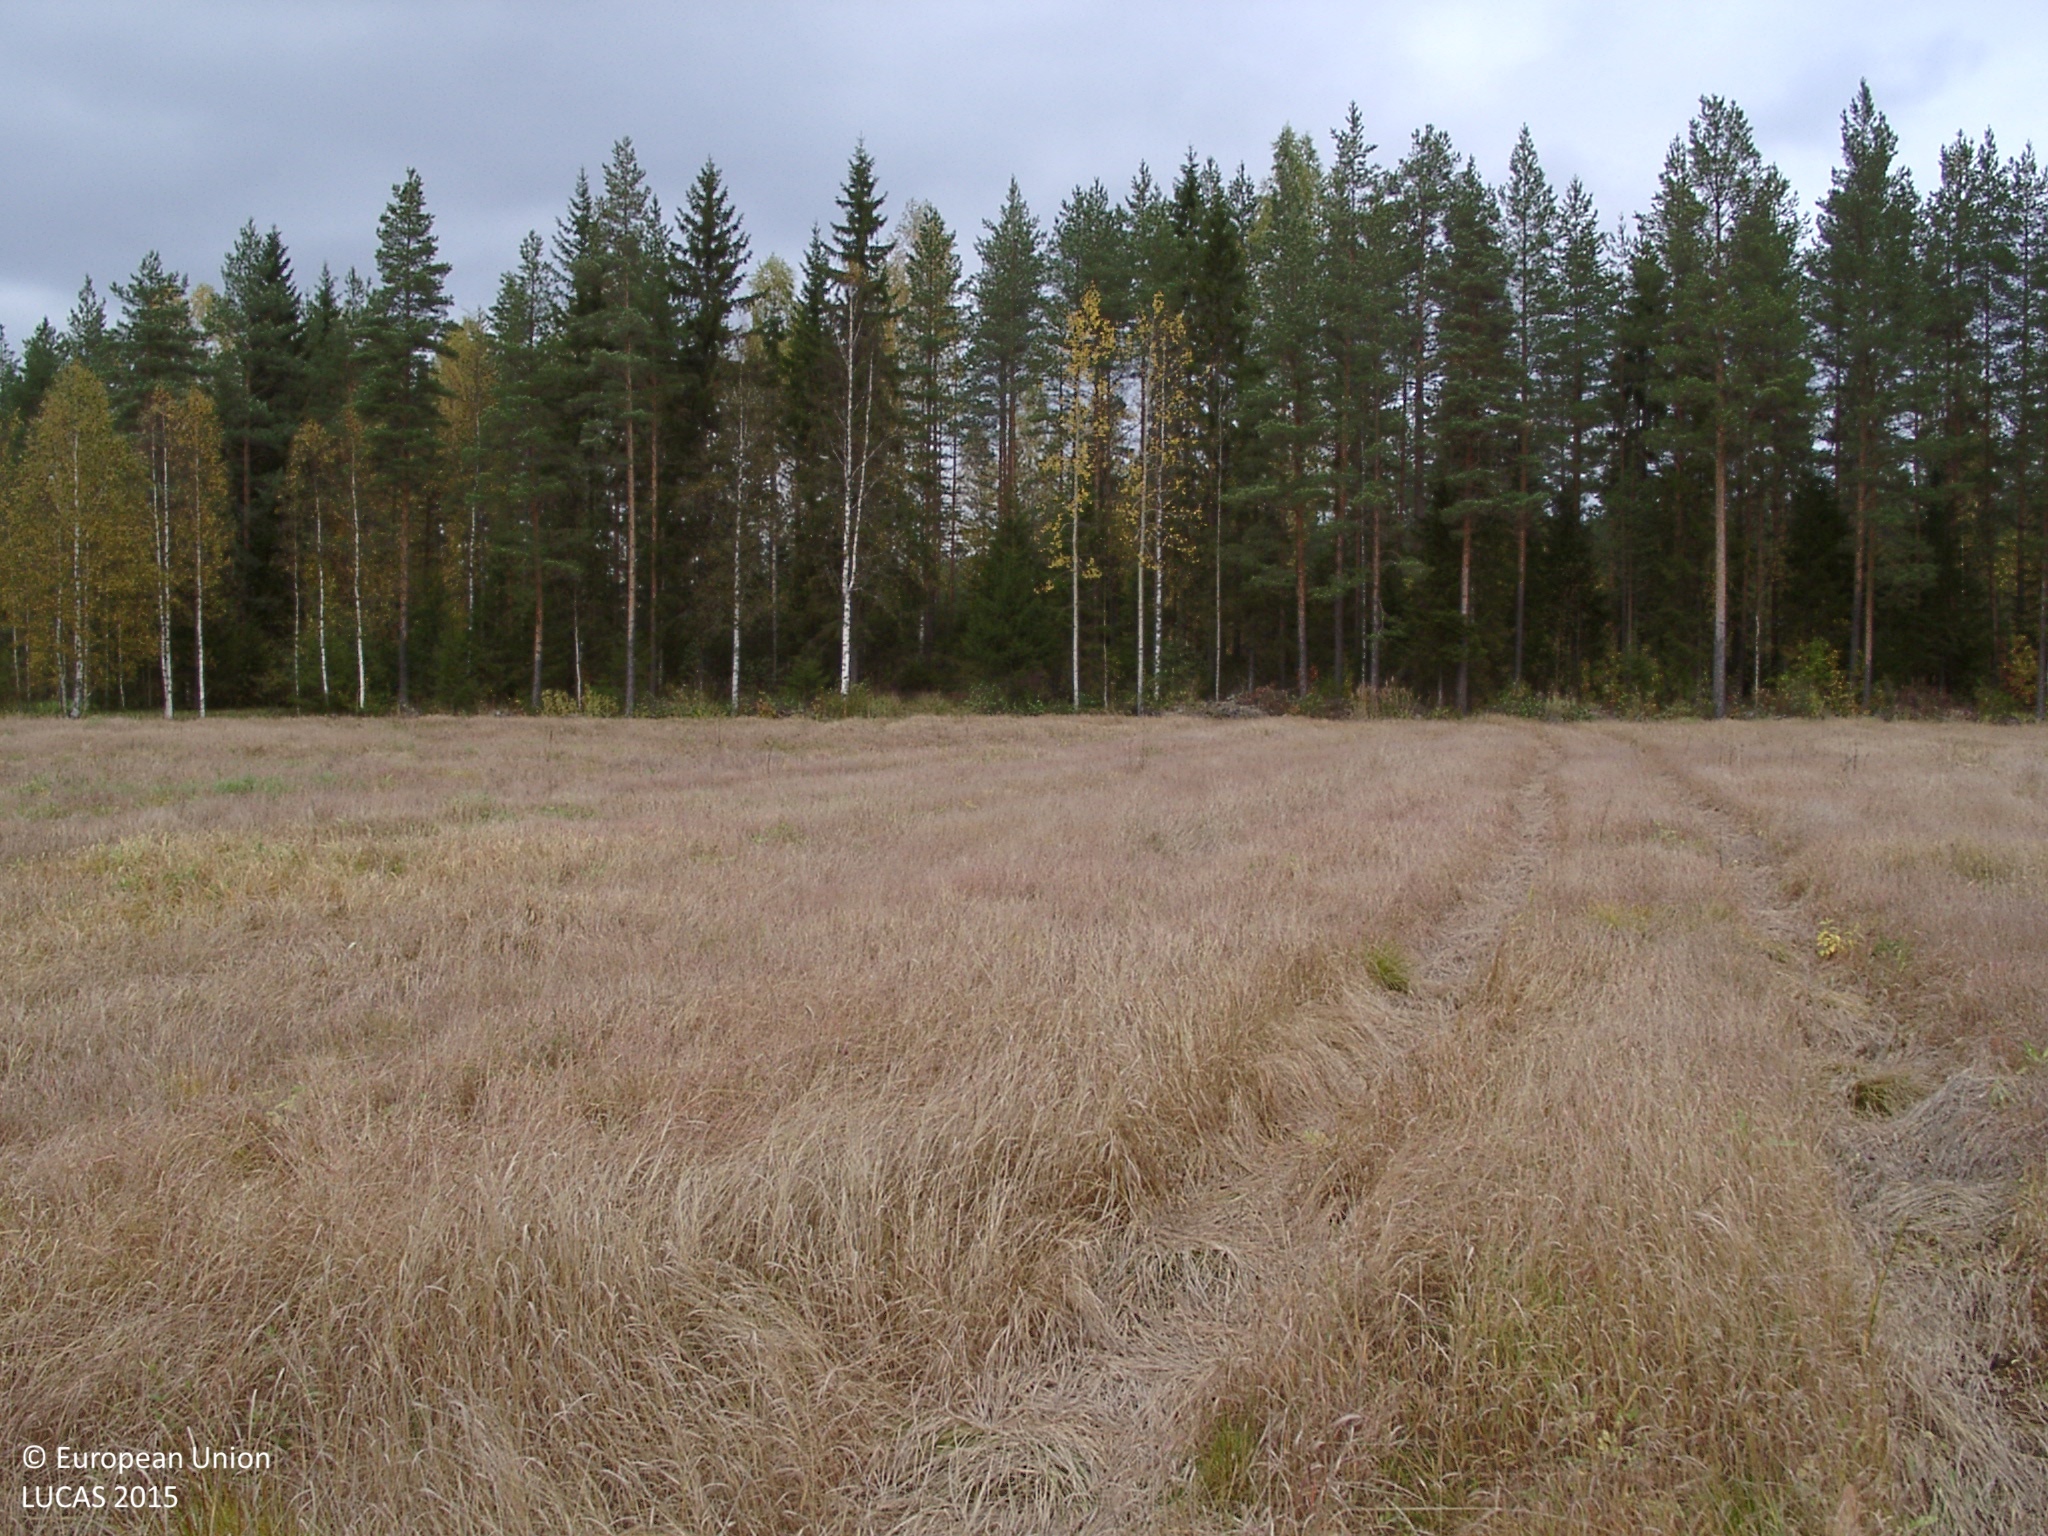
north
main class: Grassland
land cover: Spontaneously vegetated surfaces
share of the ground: > 75 %
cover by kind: herbaceous plants 100 %
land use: Fallow land
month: September
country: FI
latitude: 62.6000
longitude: 25.2788
